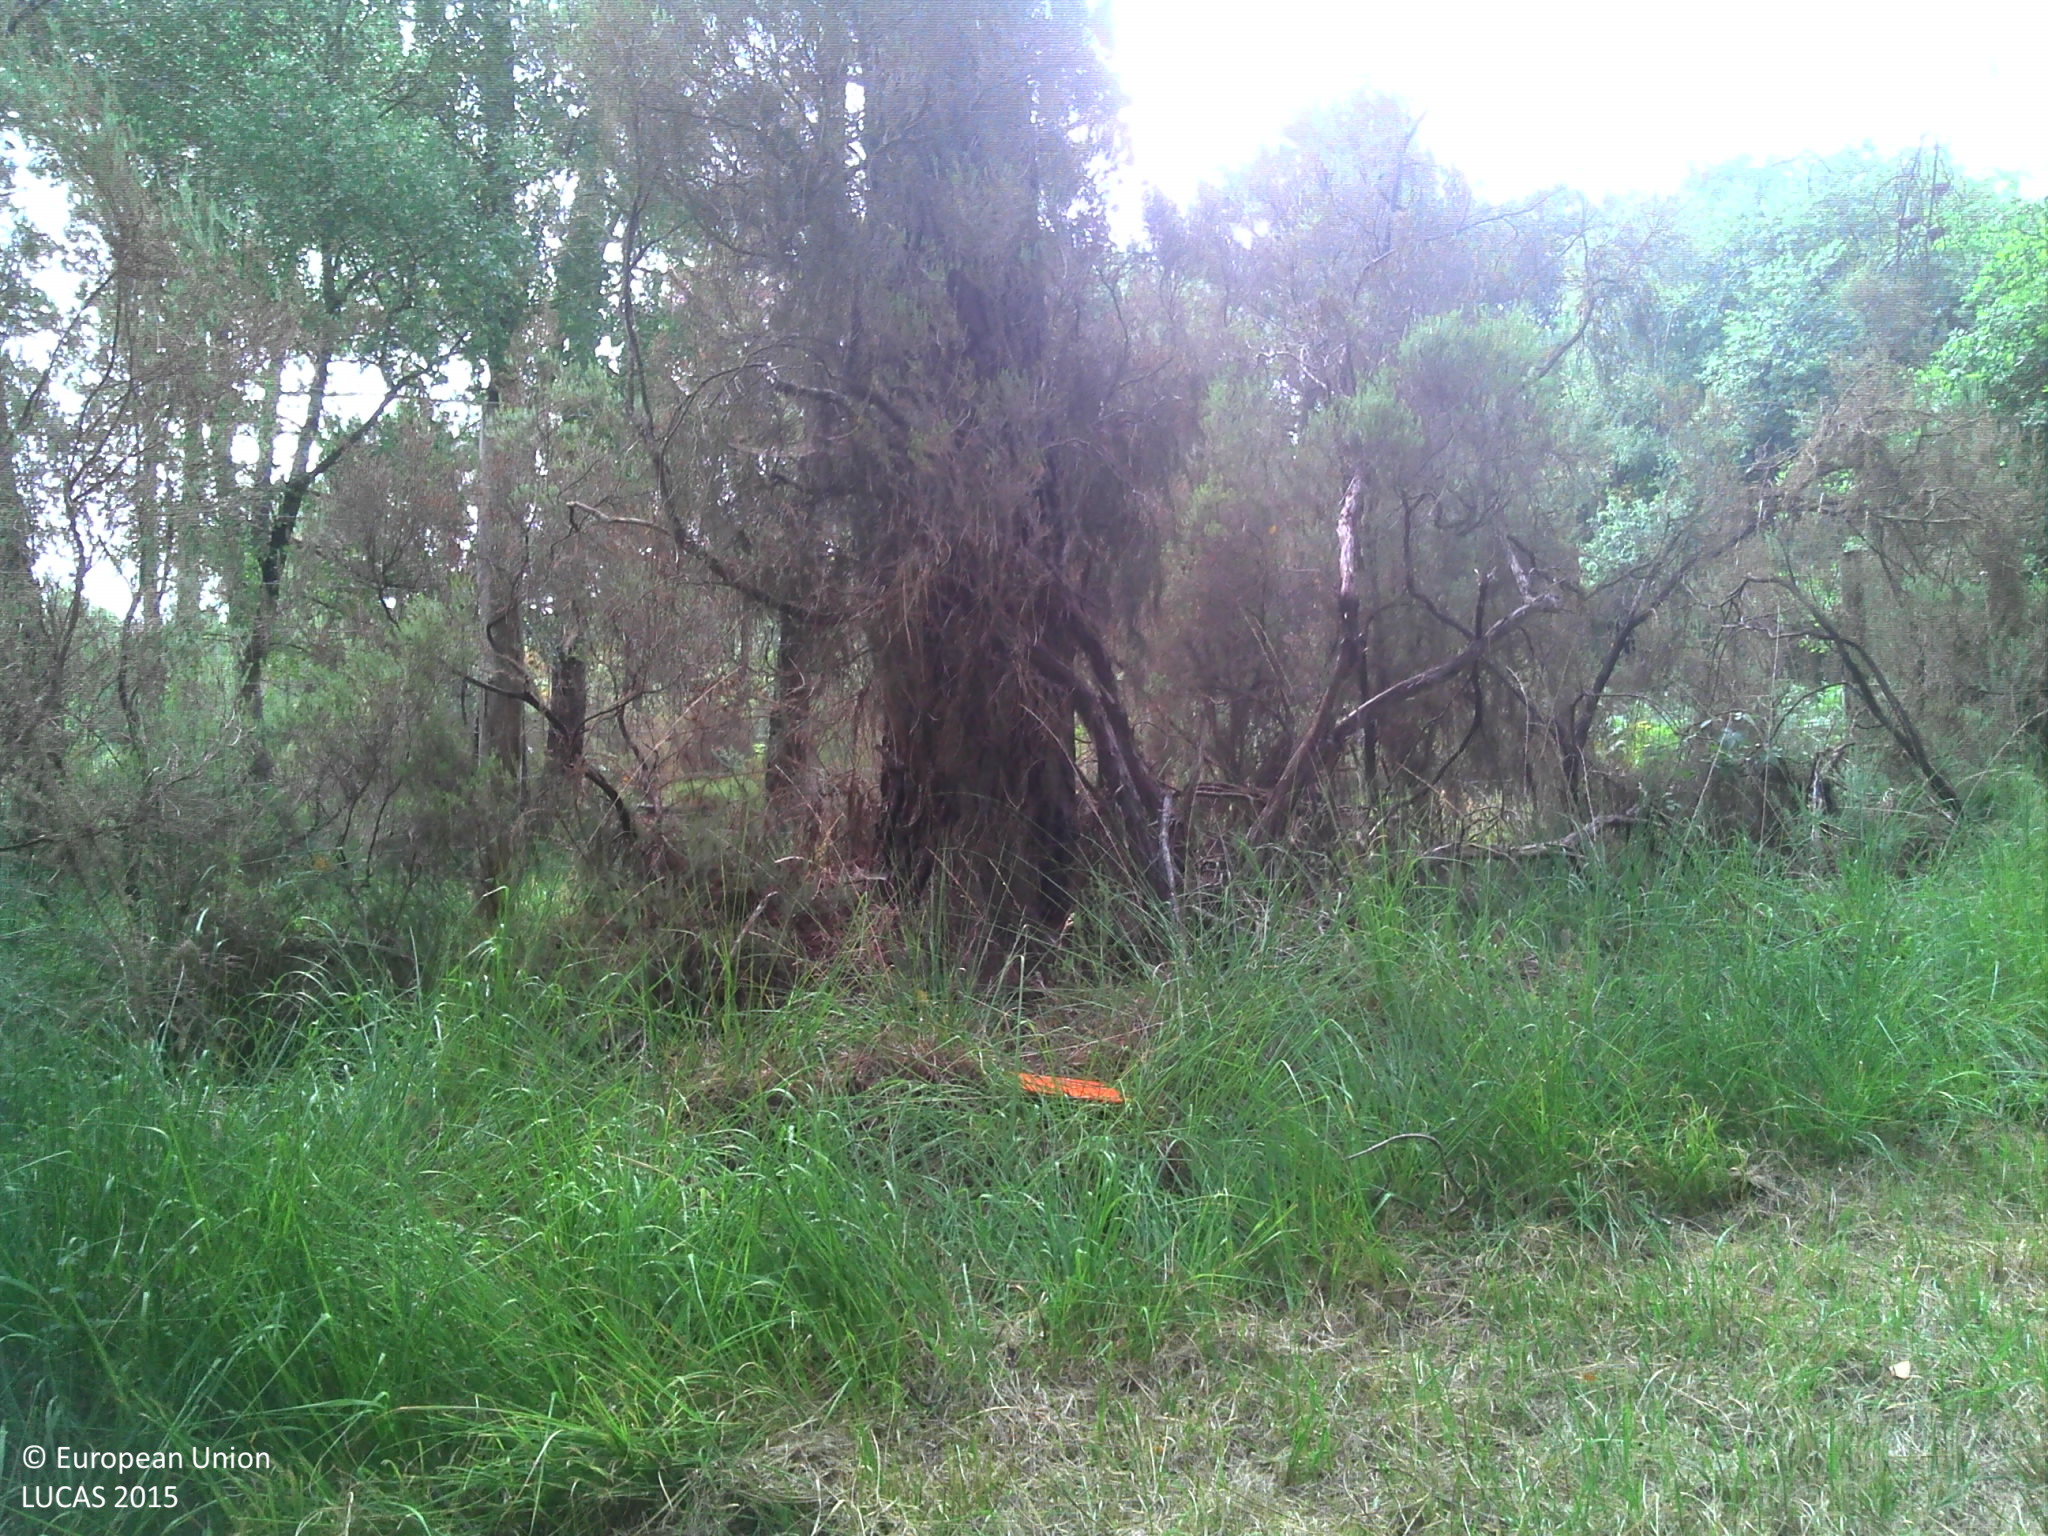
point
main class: Woodland
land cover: Pine dominated coniferous woodland
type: exotic forest
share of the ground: > 75 %
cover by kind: coniferous forest trees 55 %, herbaceous plants 20 %, broadleaved forest trees 10 %, shrubs 10 %, lichens and mosses 5 %
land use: Forestry
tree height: > 5 m
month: August
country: FR
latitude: 47.1815
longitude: 0.3322
